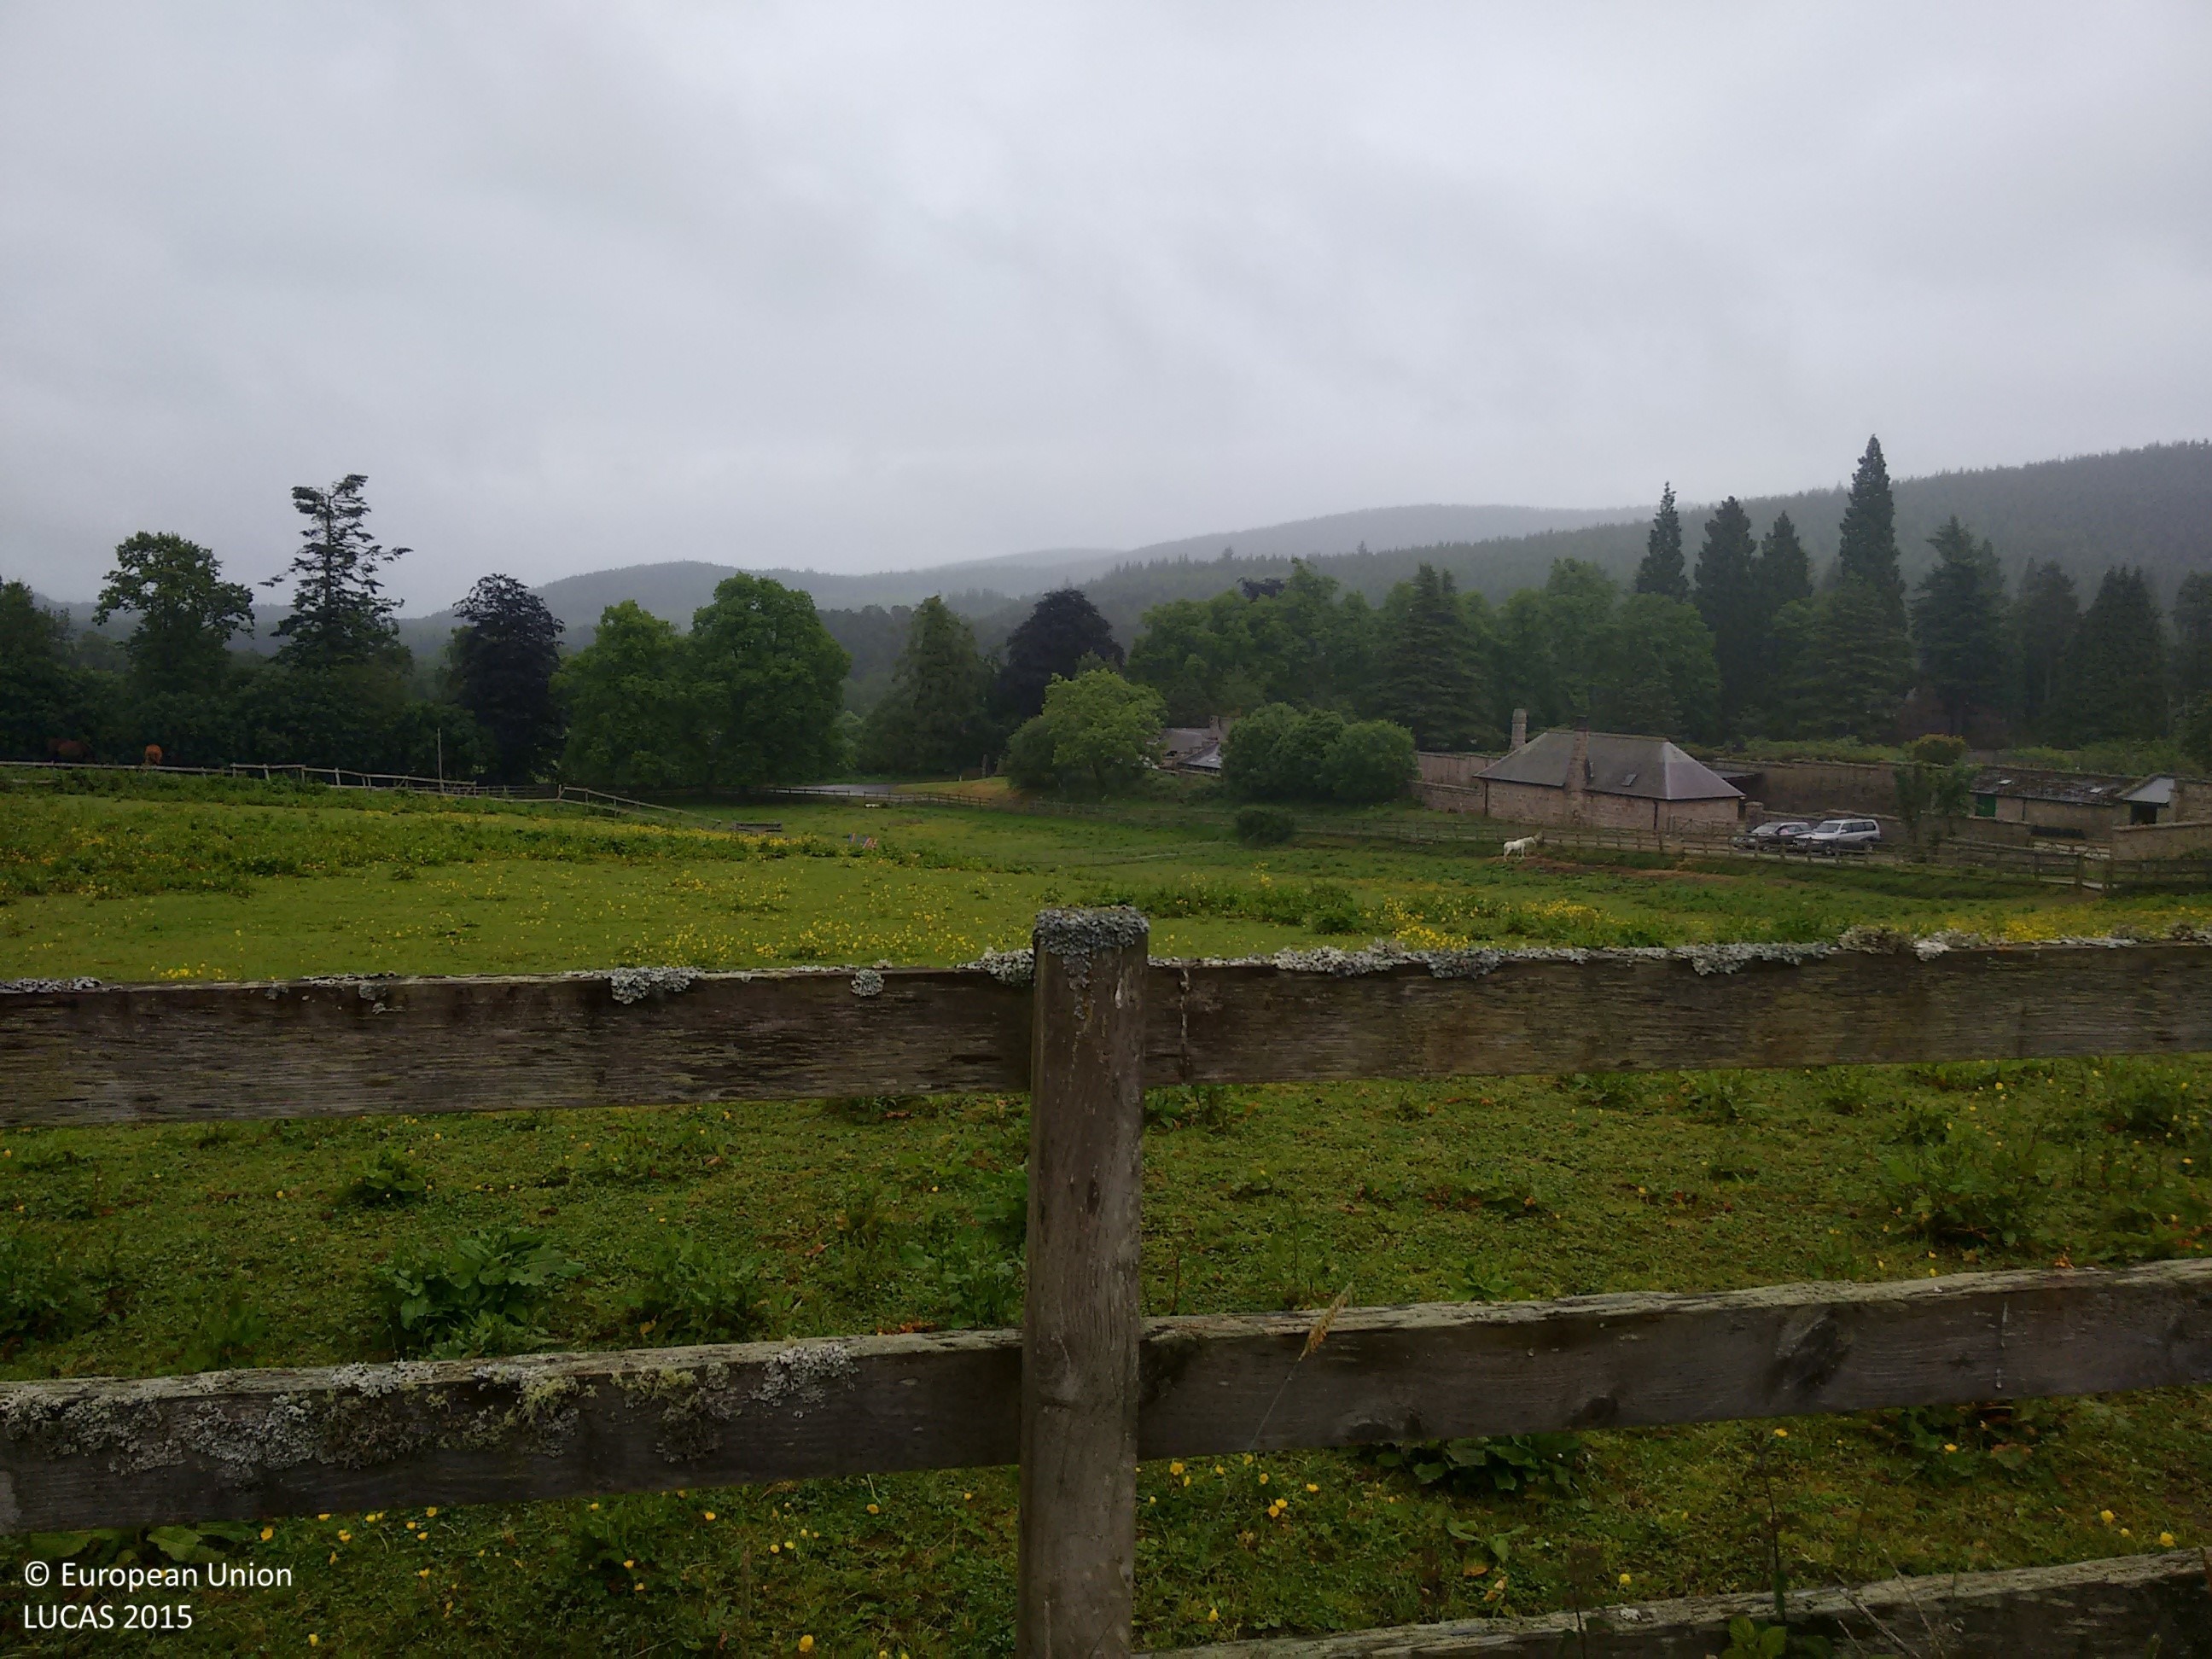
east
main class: Shrubland
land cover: Shrubland without tree cover
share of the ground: > 75 %
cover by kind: shrubs 50 %, herbaceous plants 50 %
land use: Semi-natural and natural areas not in use
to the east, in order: Shrubland without tree cover; Managed hedges; Grass margins; Paved roads, cycling and walking lanes; Grass margins; Fences; Grassland without tree/shrub cover; Artificial constructions in urban areas; Broadleaved woodland; Grassland without tree/shrub cover
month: June
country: GB
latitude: 57.0500
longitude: -2.8698
